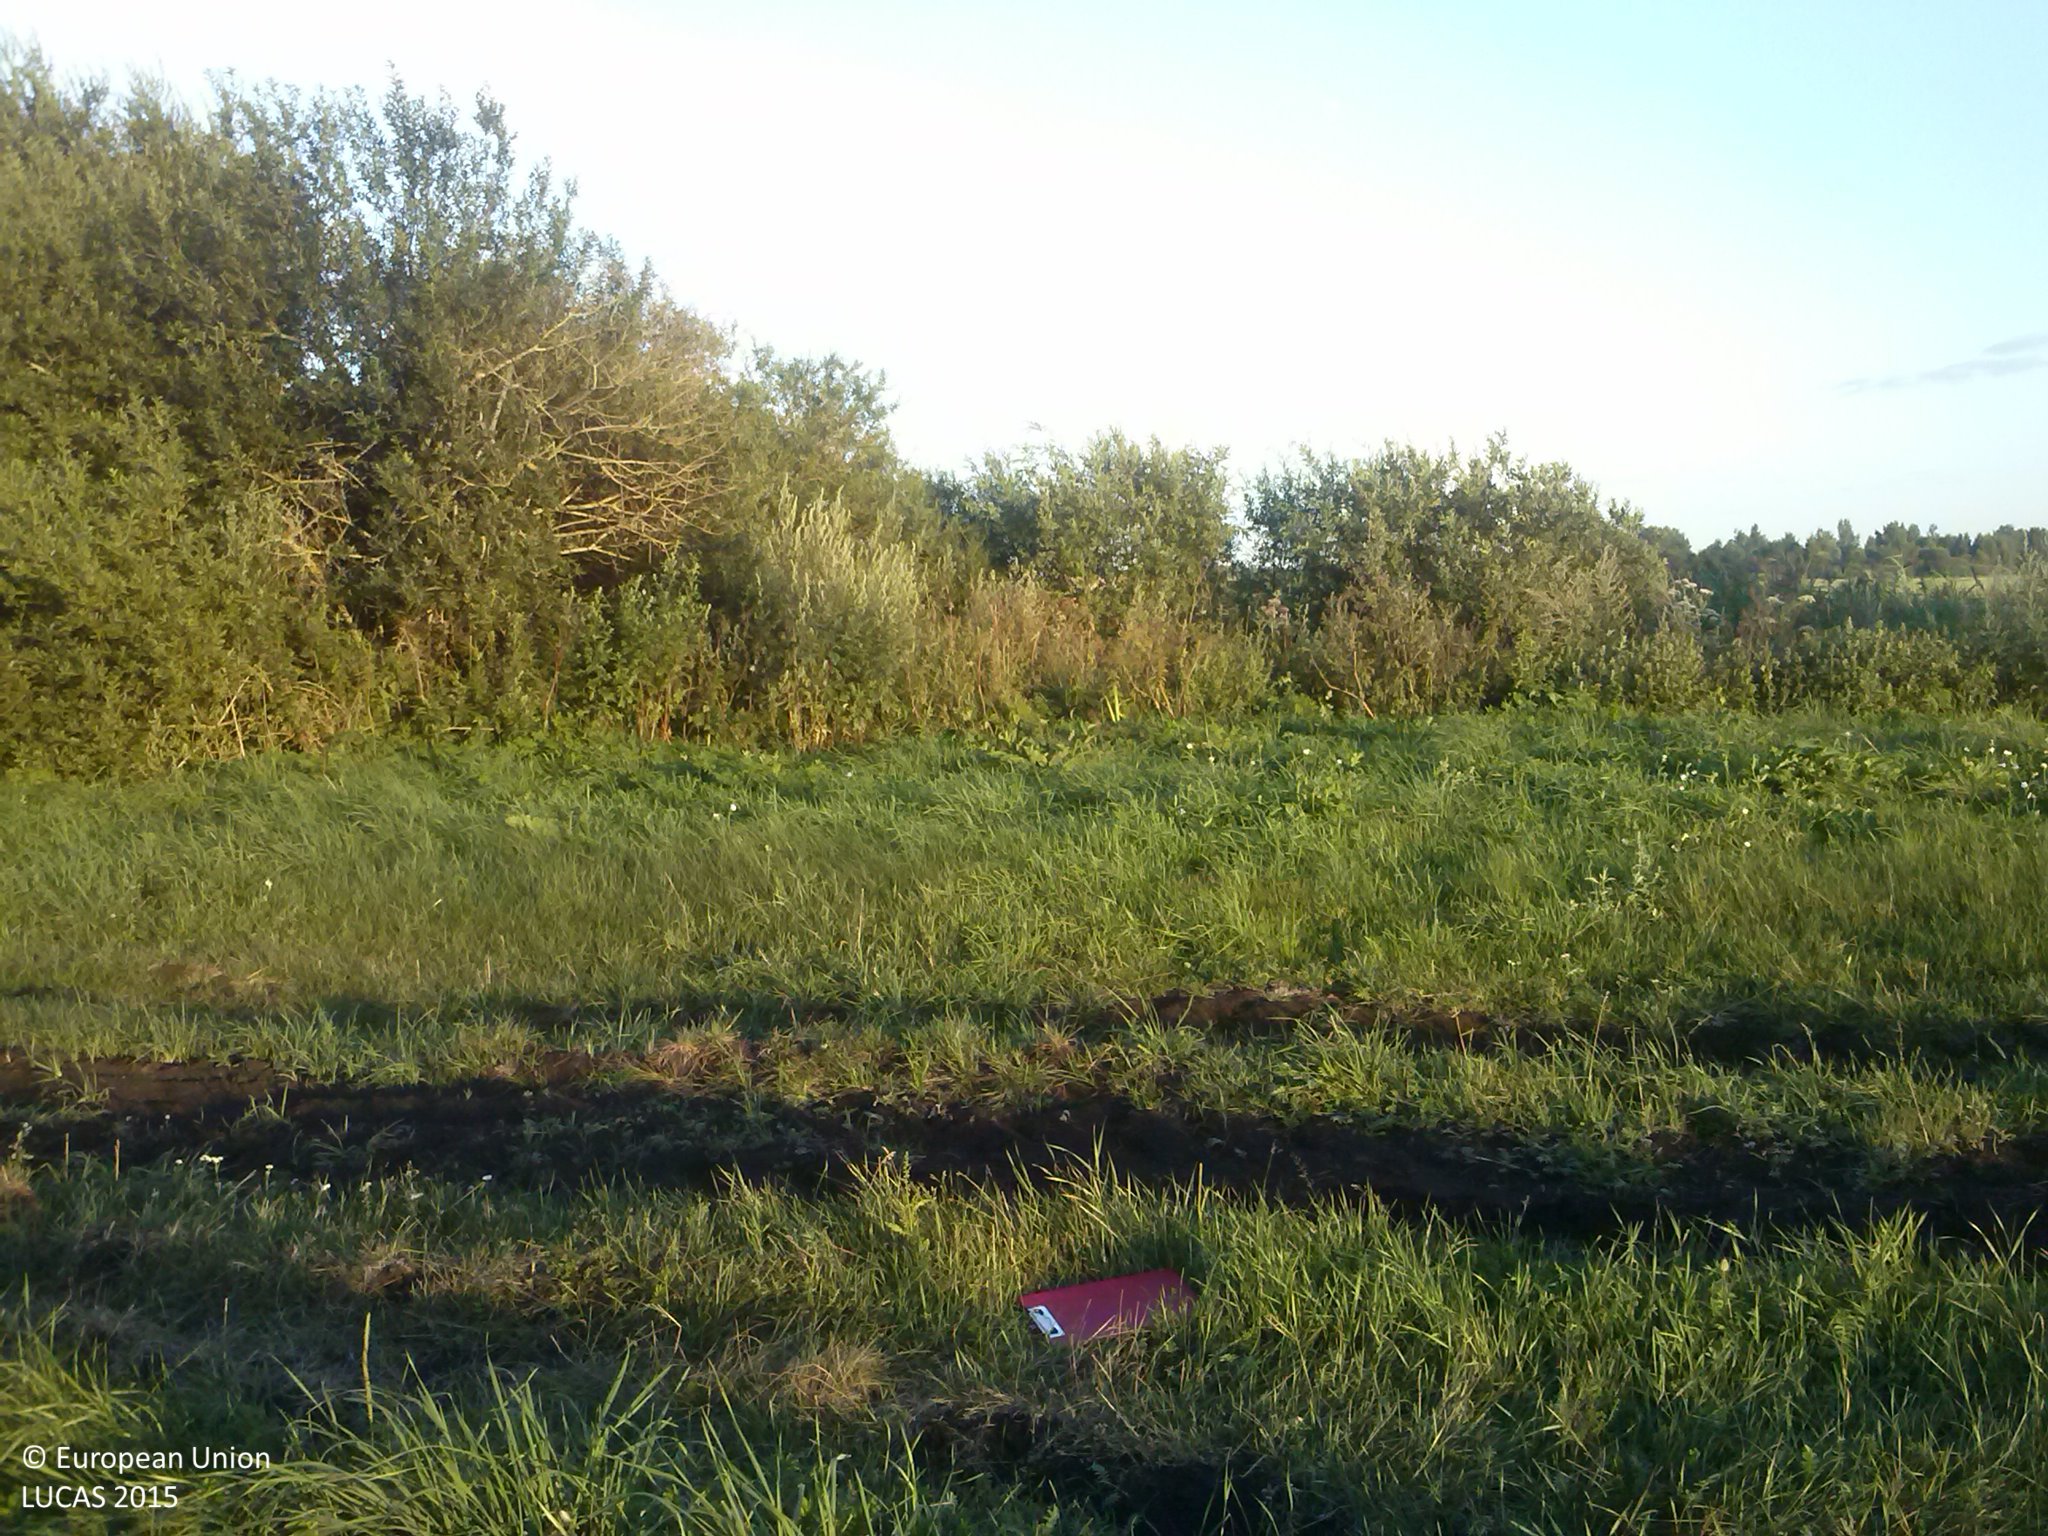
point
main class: Grassland
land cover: Grassland without tree/shrub cover
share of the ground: > 75 %
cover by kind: herbaceous plants 100 %
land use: Agriculture (excluding fallow land and kitchen gardens)
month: July
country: LV
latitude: 56.6689
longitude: 26.9520
